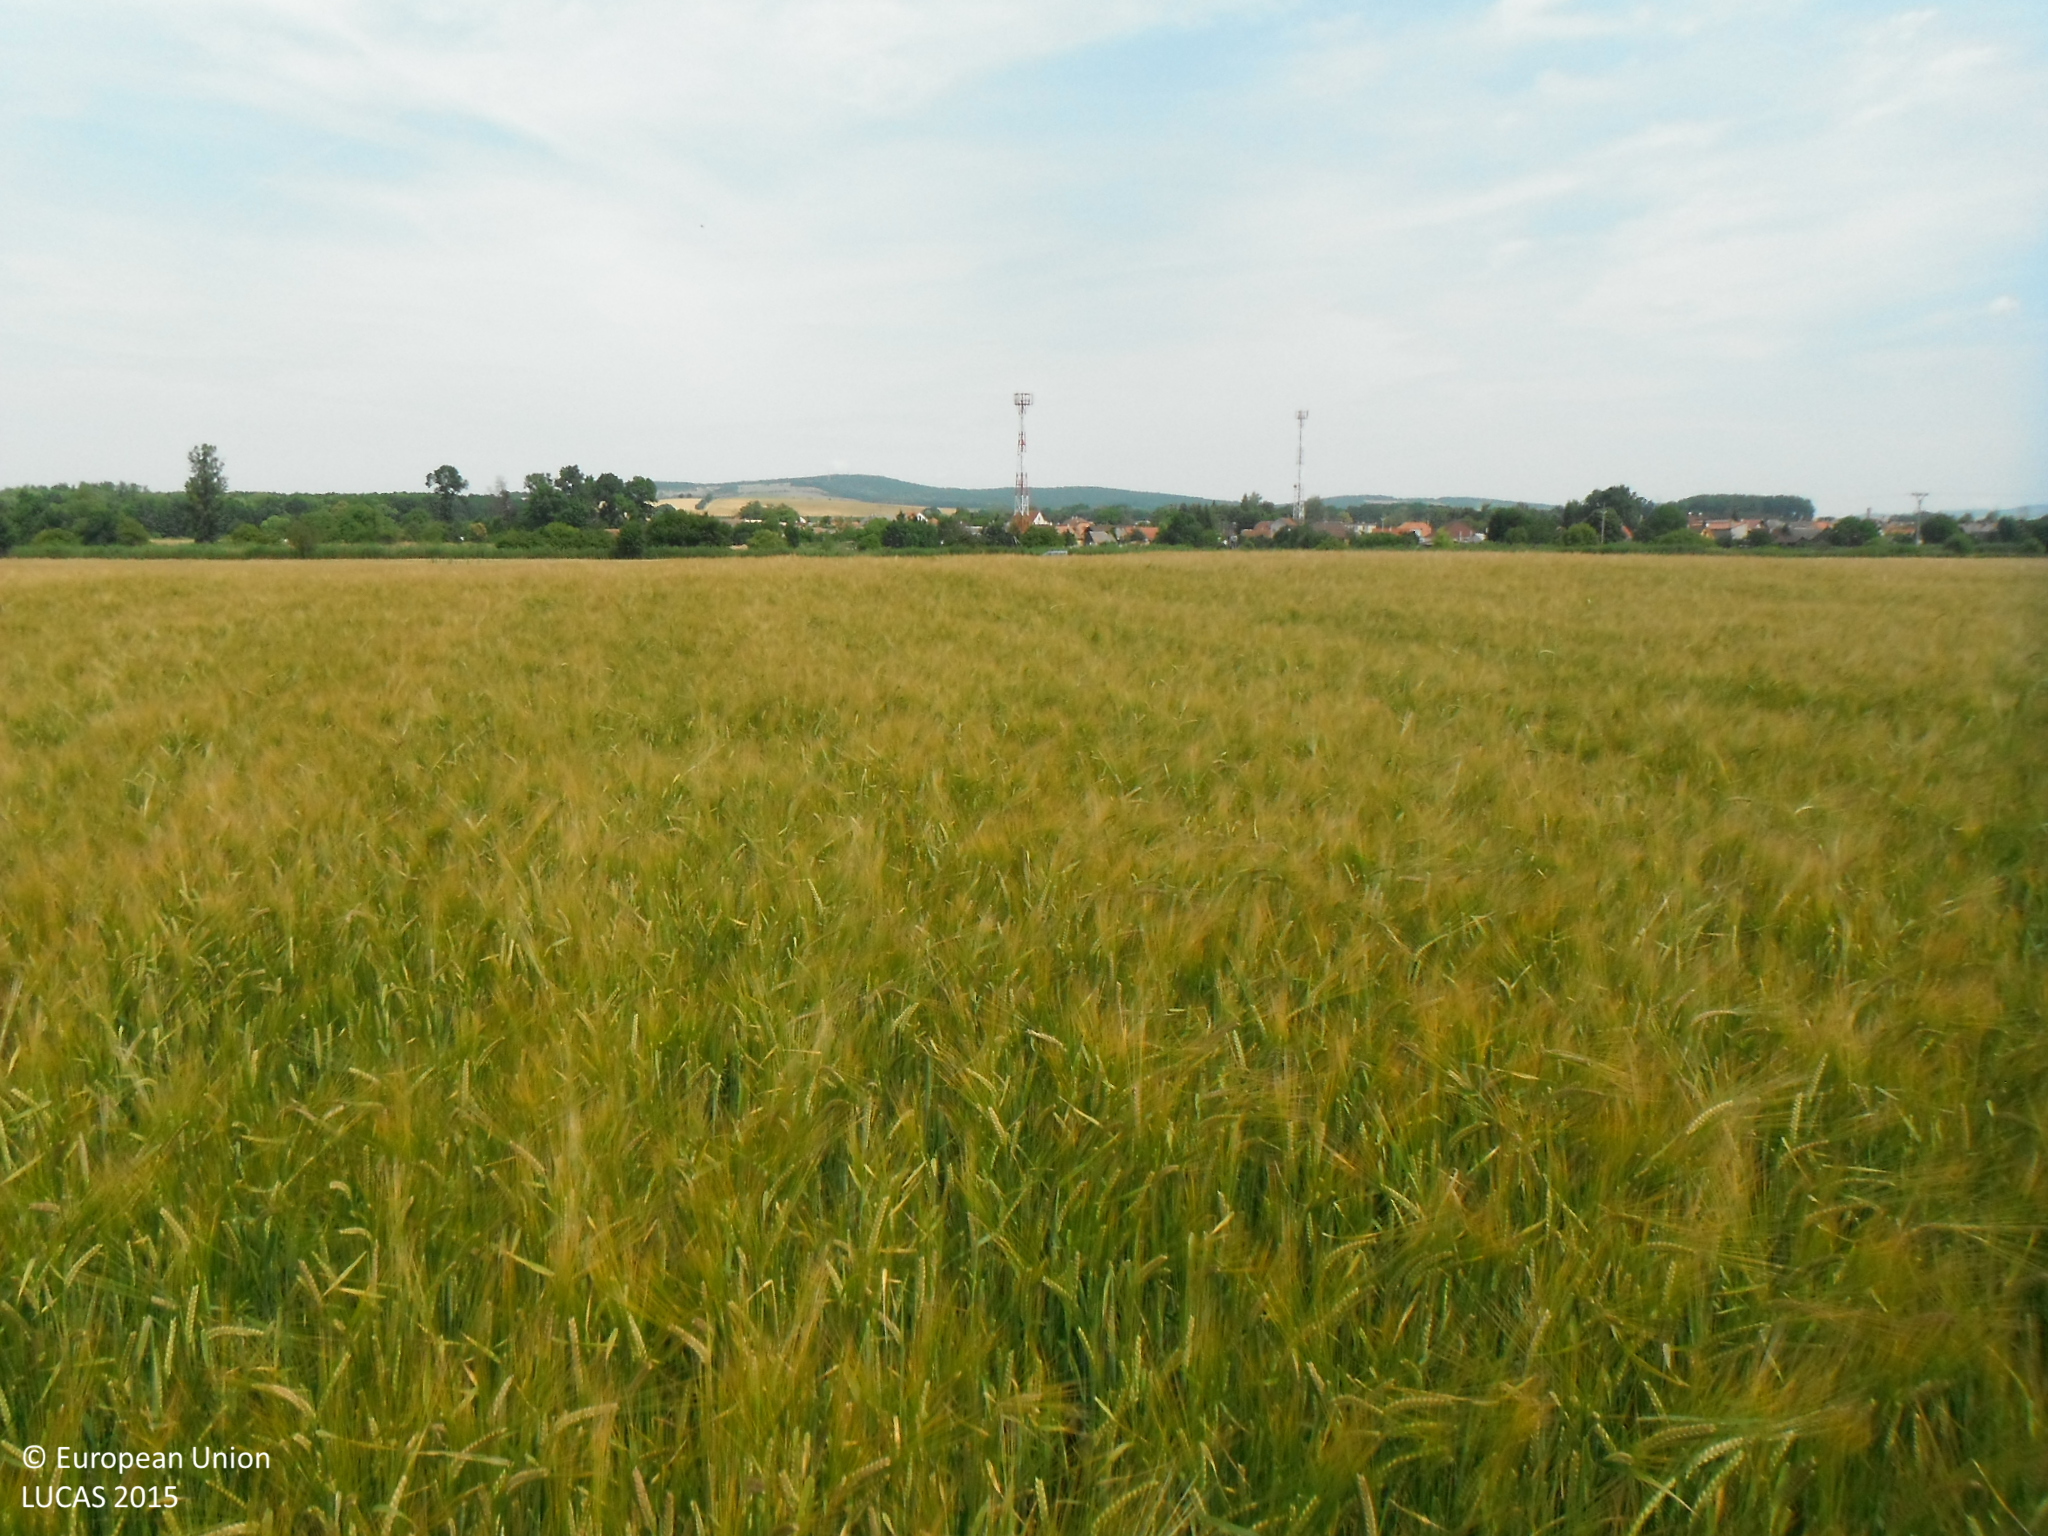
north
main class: Cropland
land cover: Barley
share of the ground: > 75 %
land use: Agriculture (excluding fallow land and kitchen gardens)
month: June
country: SK
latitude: 48.6713
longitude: 17.2475
